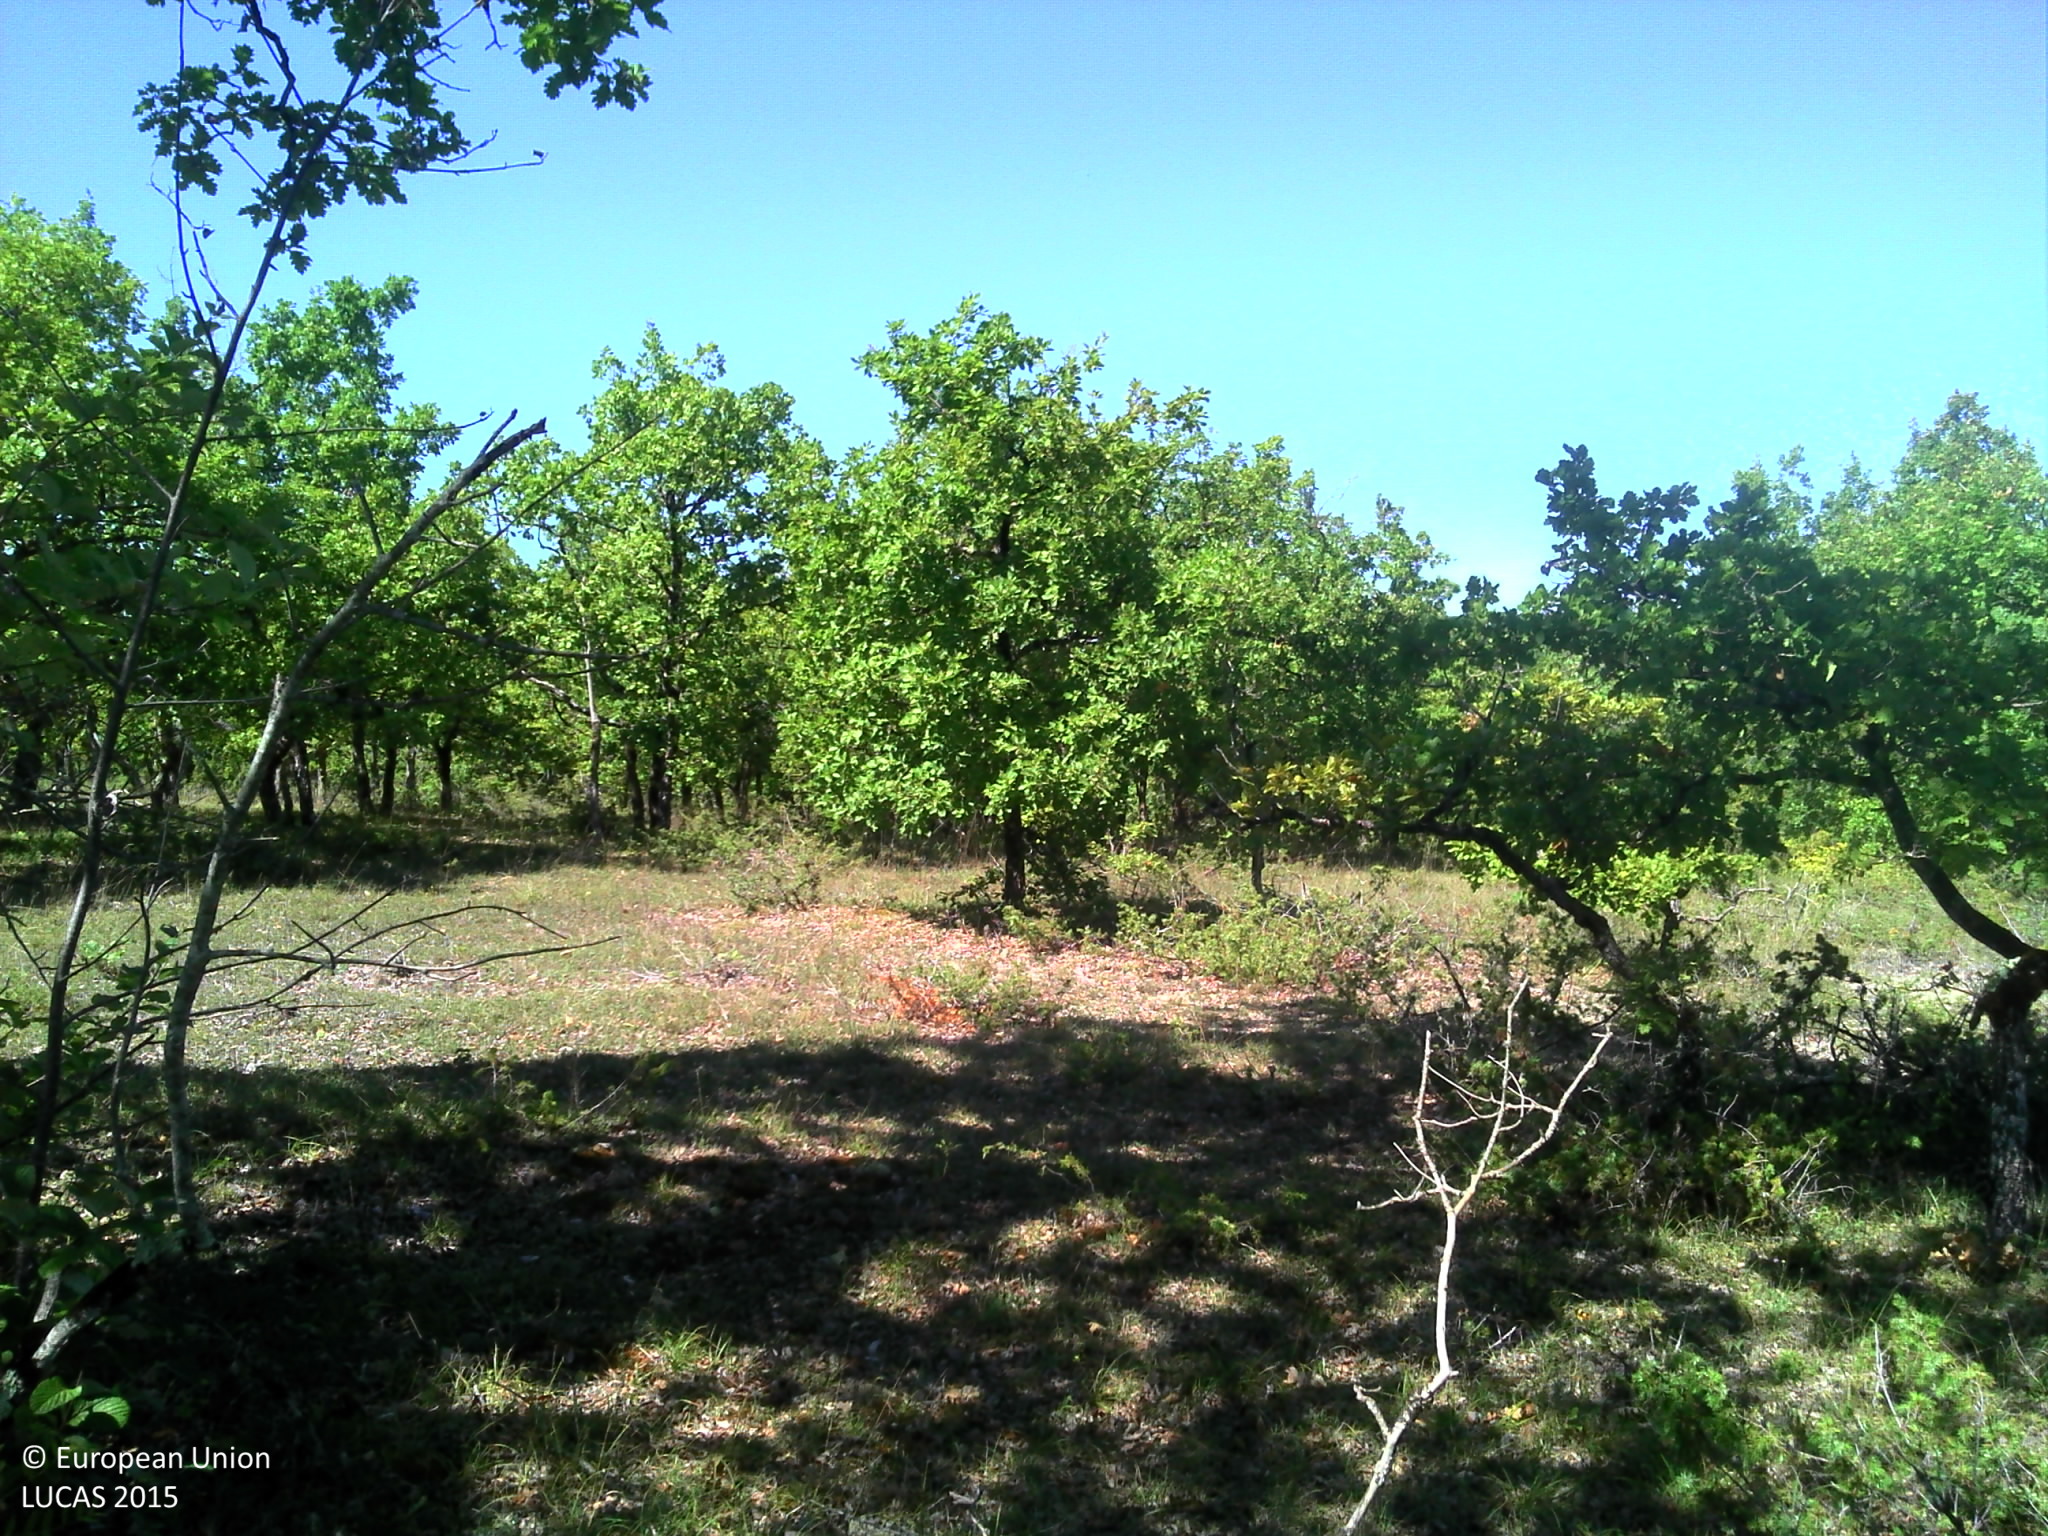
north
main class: Woodland
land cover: Broadleaved woodland
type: thermophilous deciduous forest
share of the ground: > 75 %
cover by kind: broadleaved forest trees 50 %, herbaceous plants 35 %, shrubs 10 %, lichens and mosses 5 %
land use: Forestry
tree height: > 5 m
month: August
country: FR
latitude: 44.3263
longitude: 1.4845
